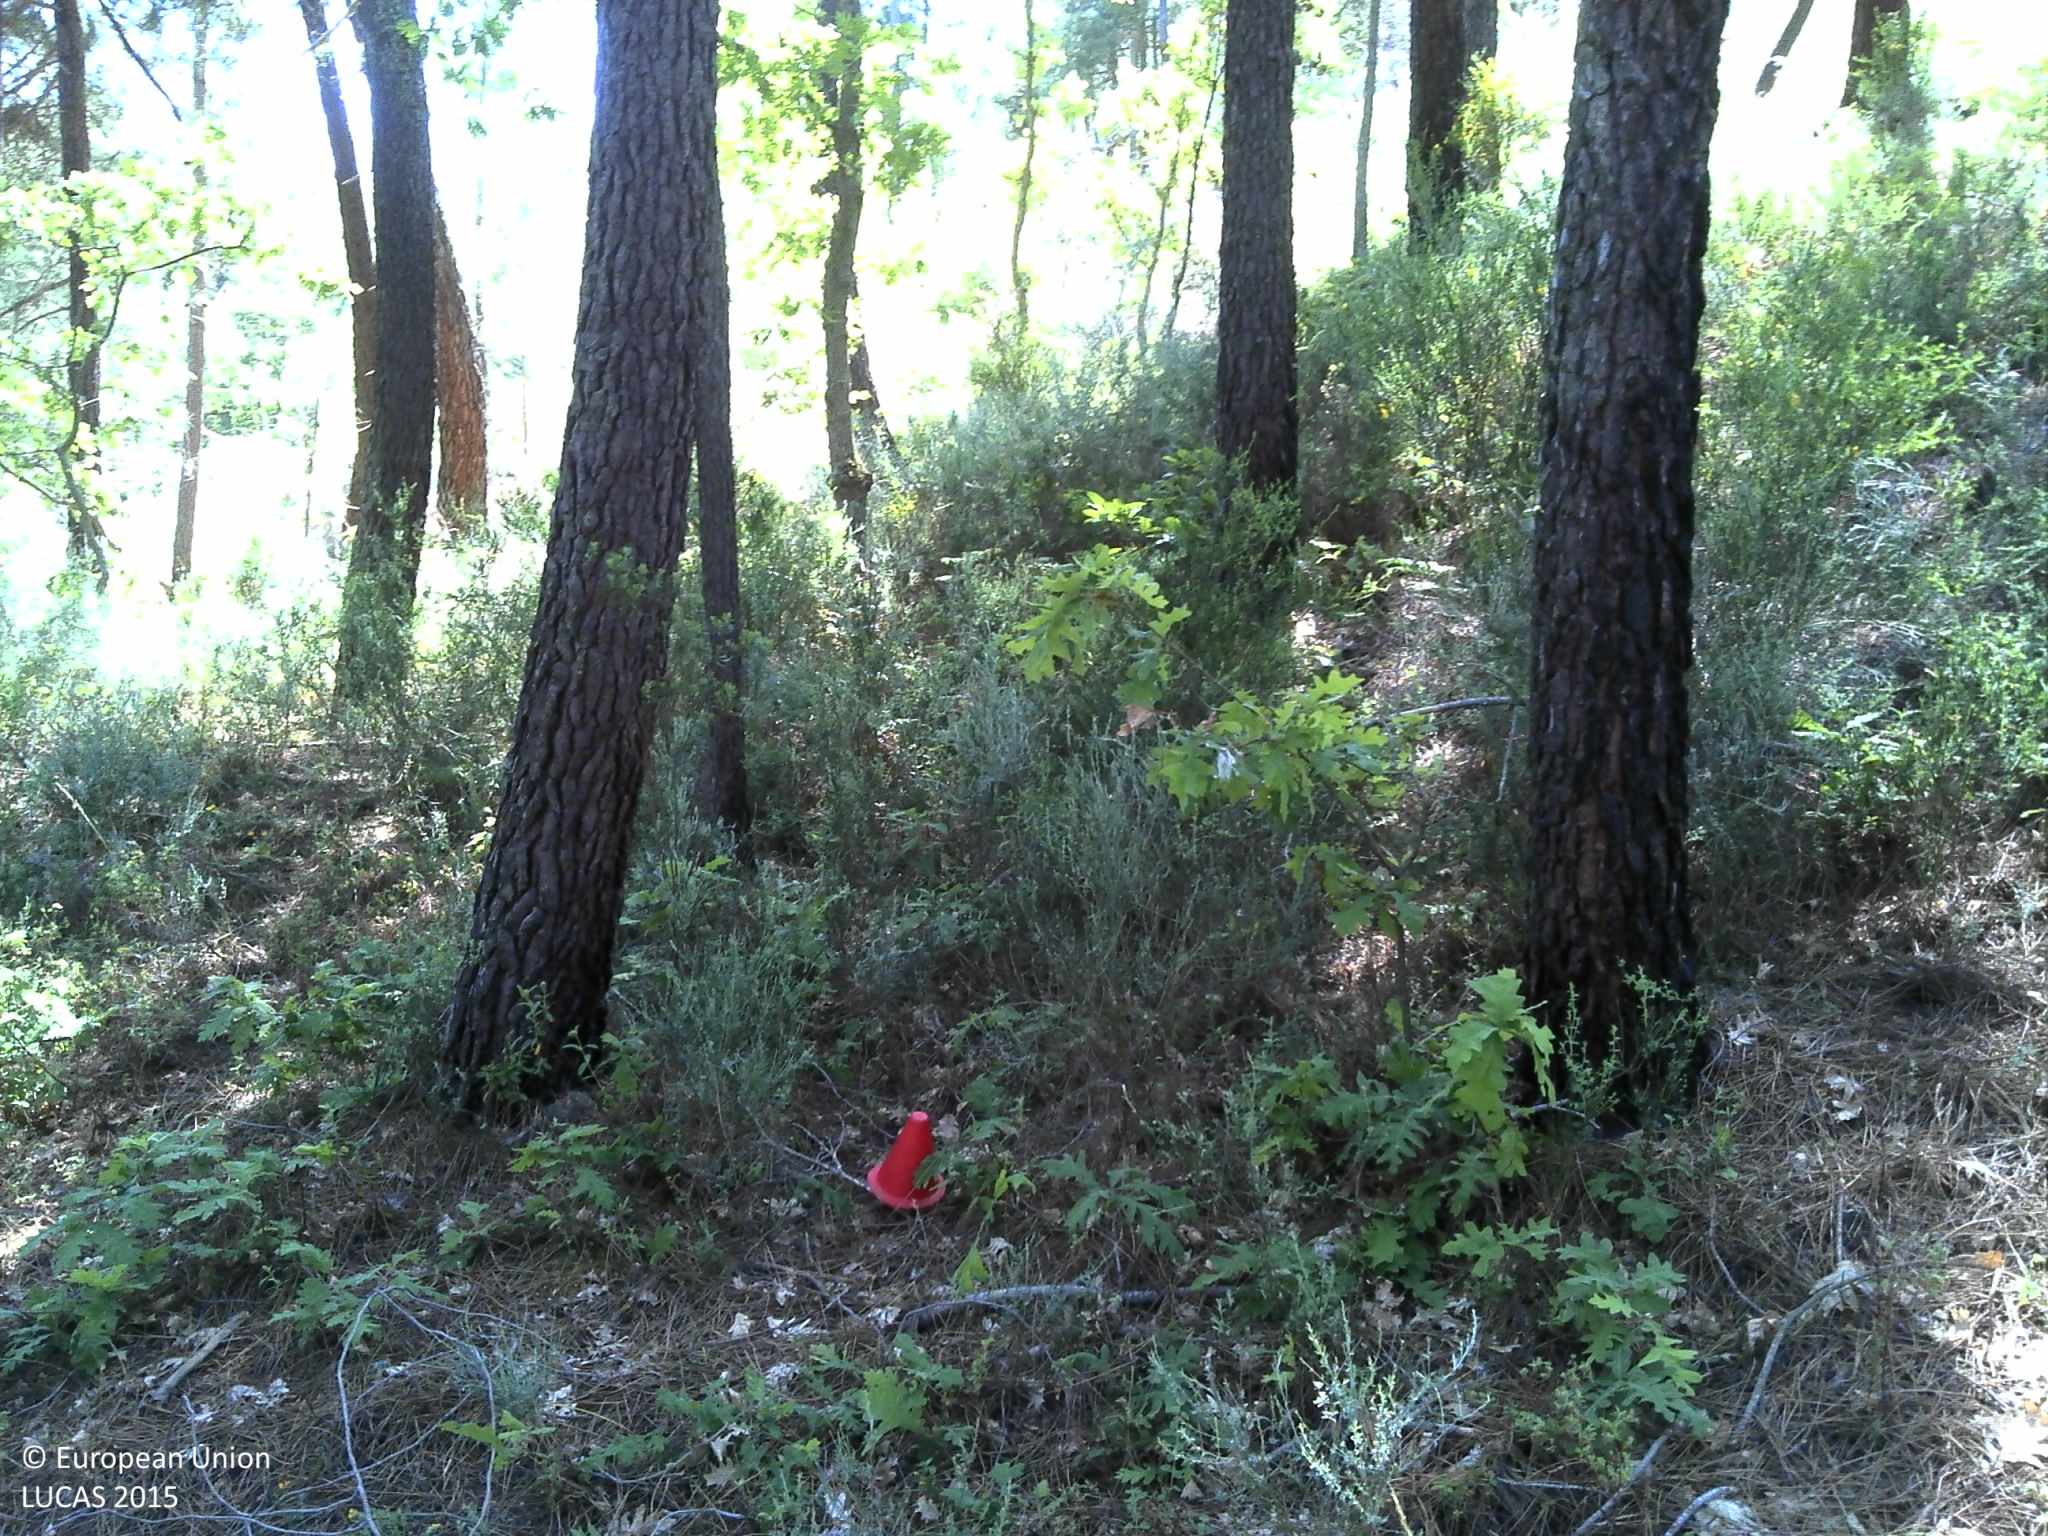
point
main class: Woodland
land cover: Pine dominated coniferous woodland
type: coniferous forest of the mediterranean region
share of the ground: 50 - 75 %
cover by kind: coniferous forest trees 60 %, shrubs 30 %, broadleaved forest trees 5 %, unconsolidated bare surface 5 %
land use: Forestry
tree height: > 5 m
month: May
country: PT
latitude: 41.5936
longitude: -7.5123
